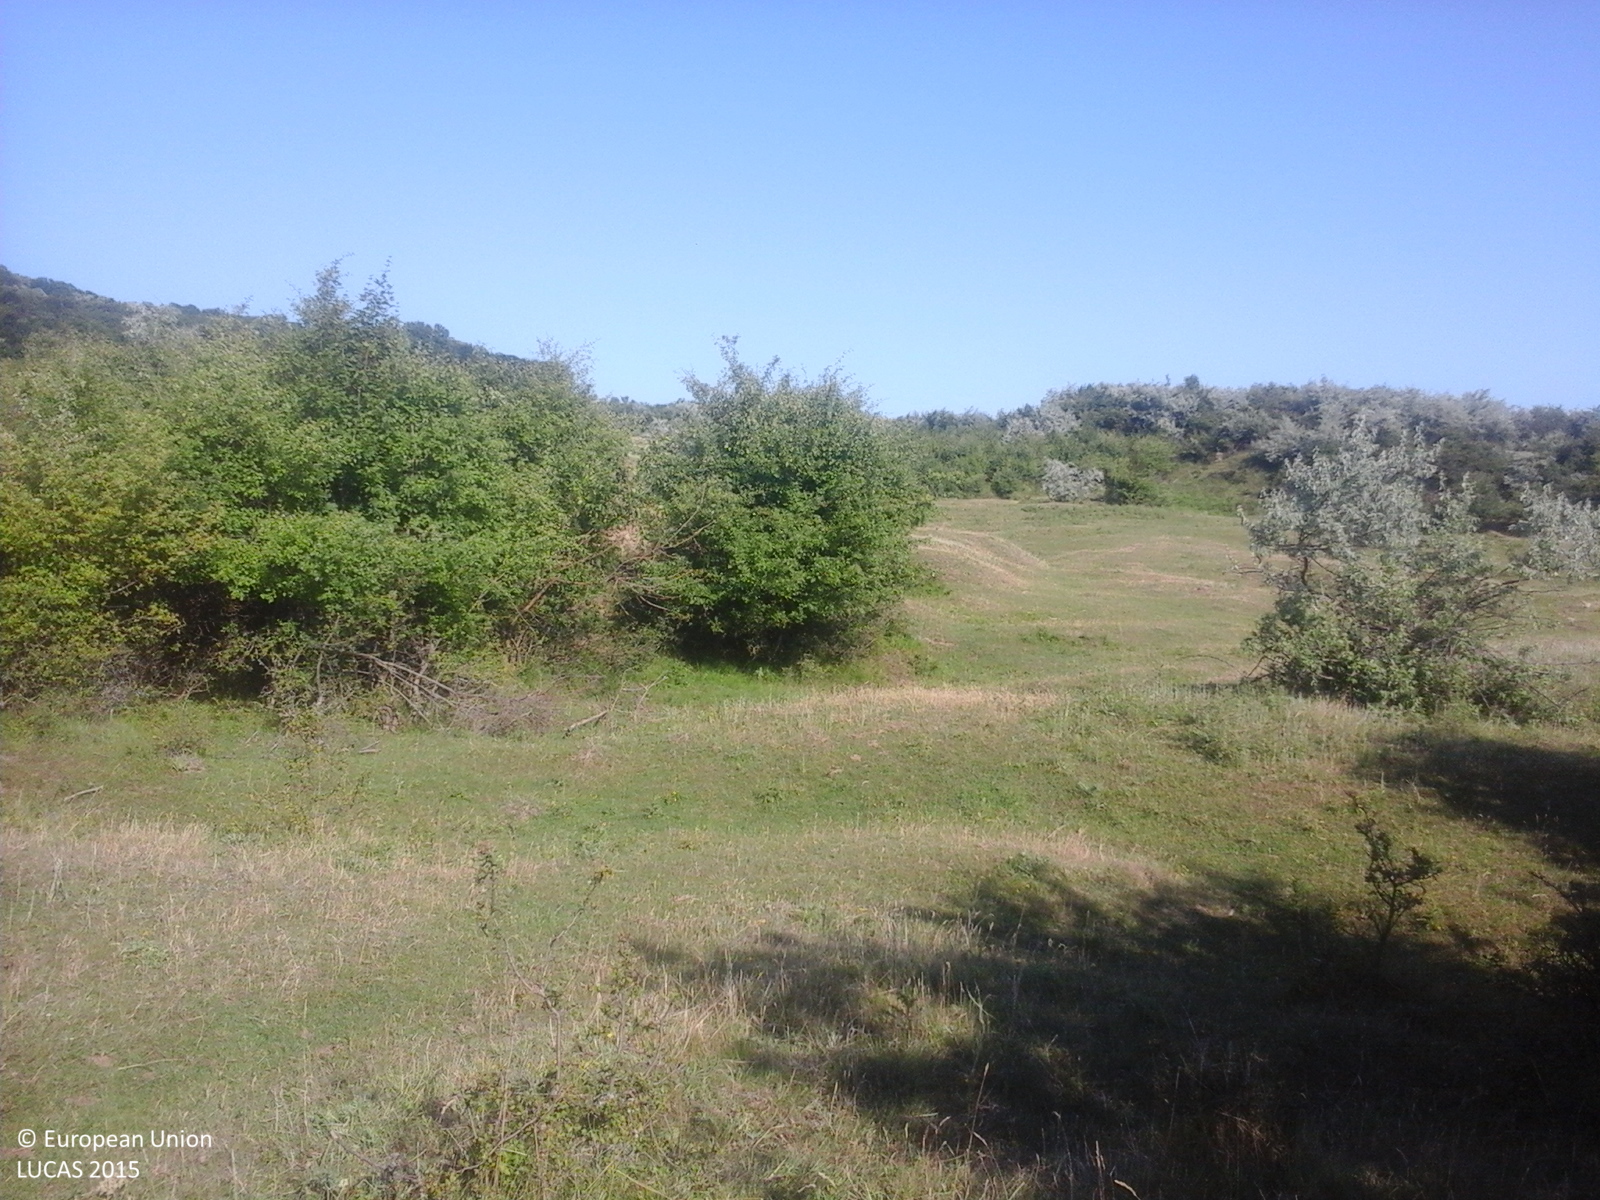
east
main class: Shrubland
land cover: Shrubland with sparse tree cover
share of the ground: > 75 %
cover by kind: herbaceous plants 85 %, shrubs 10 %, broadleaved forest trees 5 %
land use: Agriculture (excluding fallow land and kitchen gardens)
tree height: < 5 m
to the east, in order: Shrubland with sparse tree cover; Grassland without tree/shrub cover
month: June
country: RO
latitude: 46.9990
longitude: 27.3509
